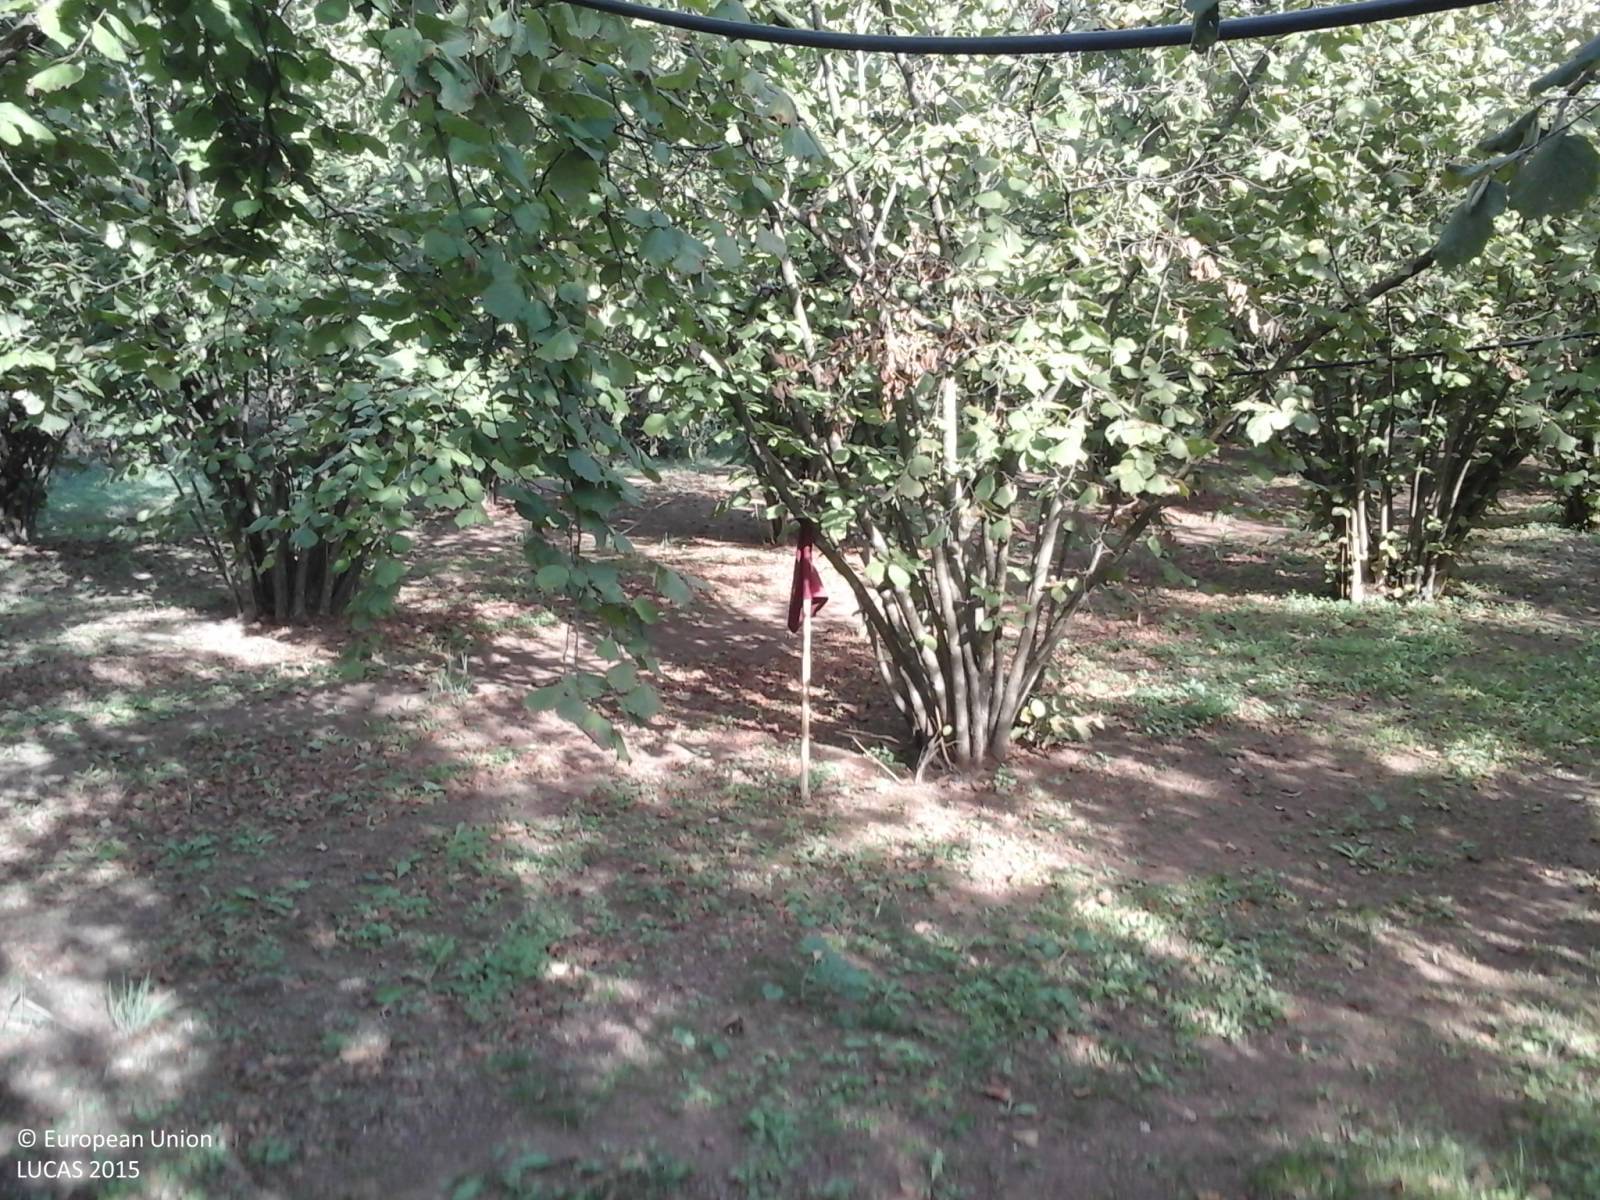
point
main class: Cropland
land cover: Nuts trees
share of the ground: > 75 %
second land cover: Other bare soil
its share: > 75 %
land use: Agriculture (excluding fallow land and kitchen gardens)
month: September
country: IT
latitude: 42.3555
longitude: 12.3593
